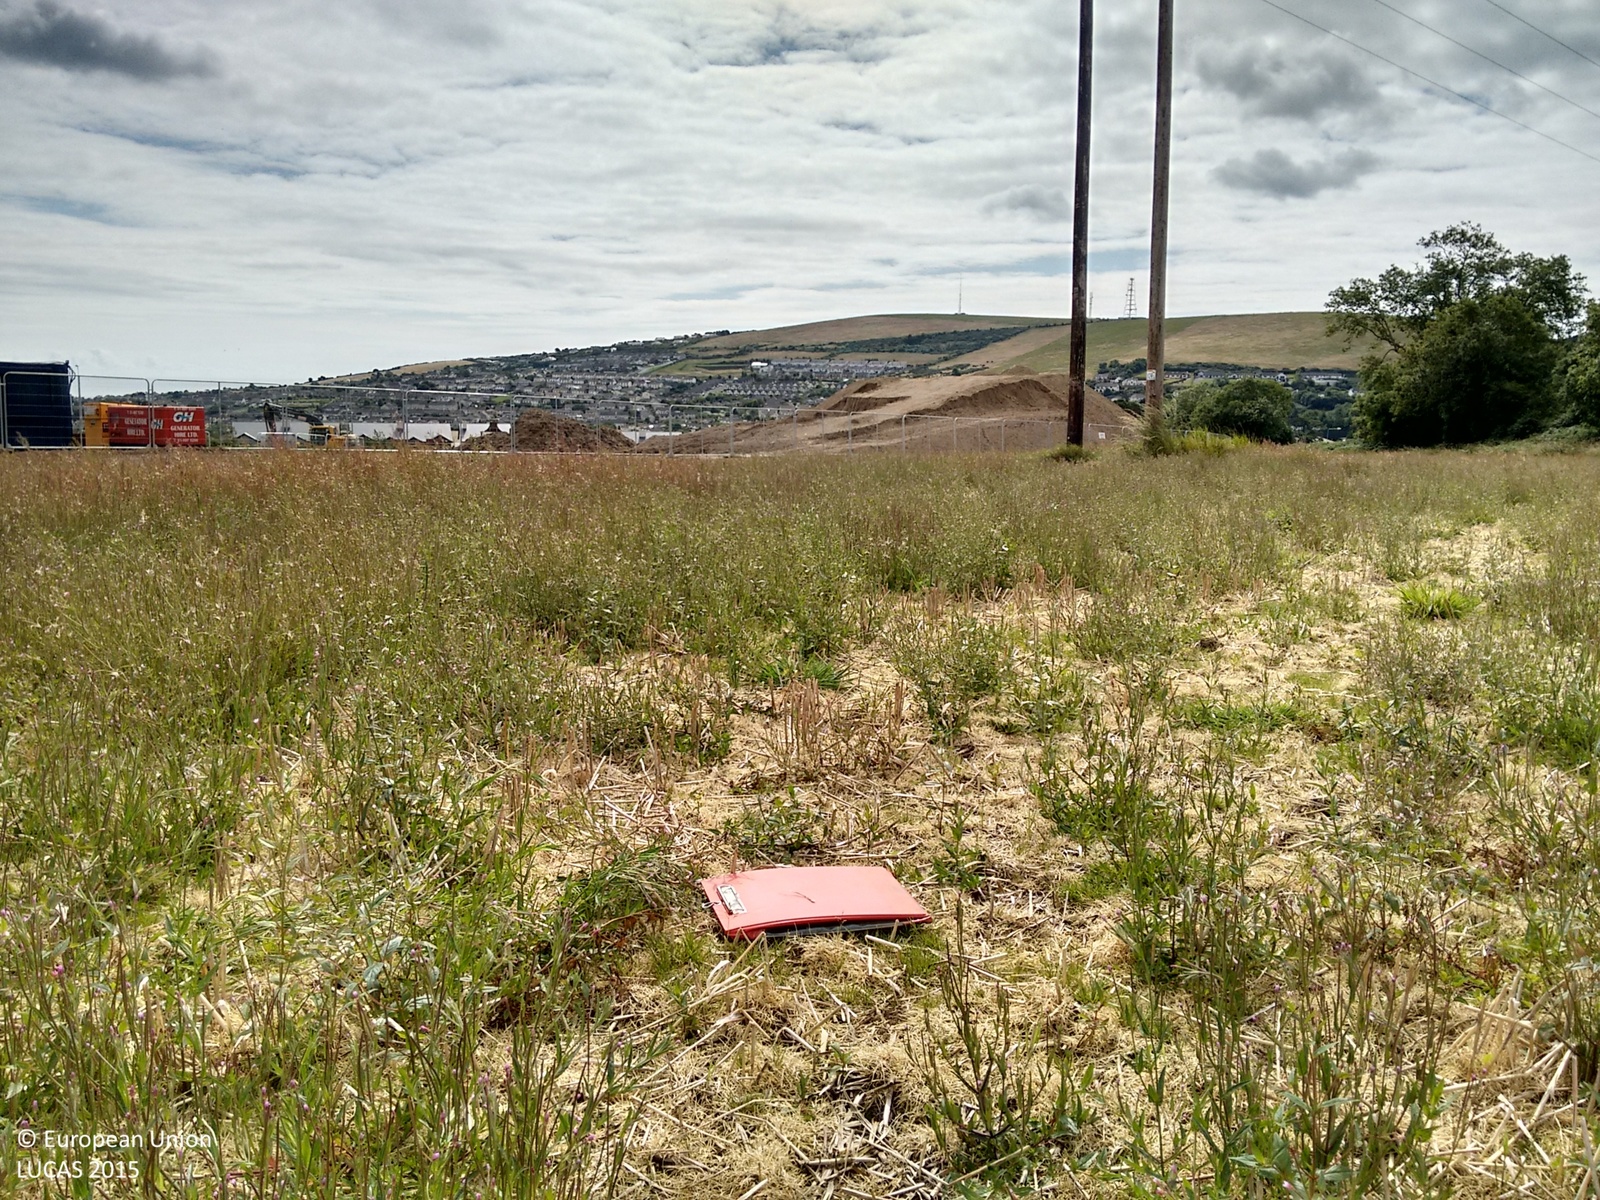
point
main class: Grassland
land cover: Spontaneously vegetated surfaces
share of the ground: > 75 %
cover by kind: herbaceous plants 80 %, unconsolidated bare surface 20 %
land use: Semi-natural and natural areas not in use
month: July
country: IE
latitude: 52.9797
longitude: -6.0660
